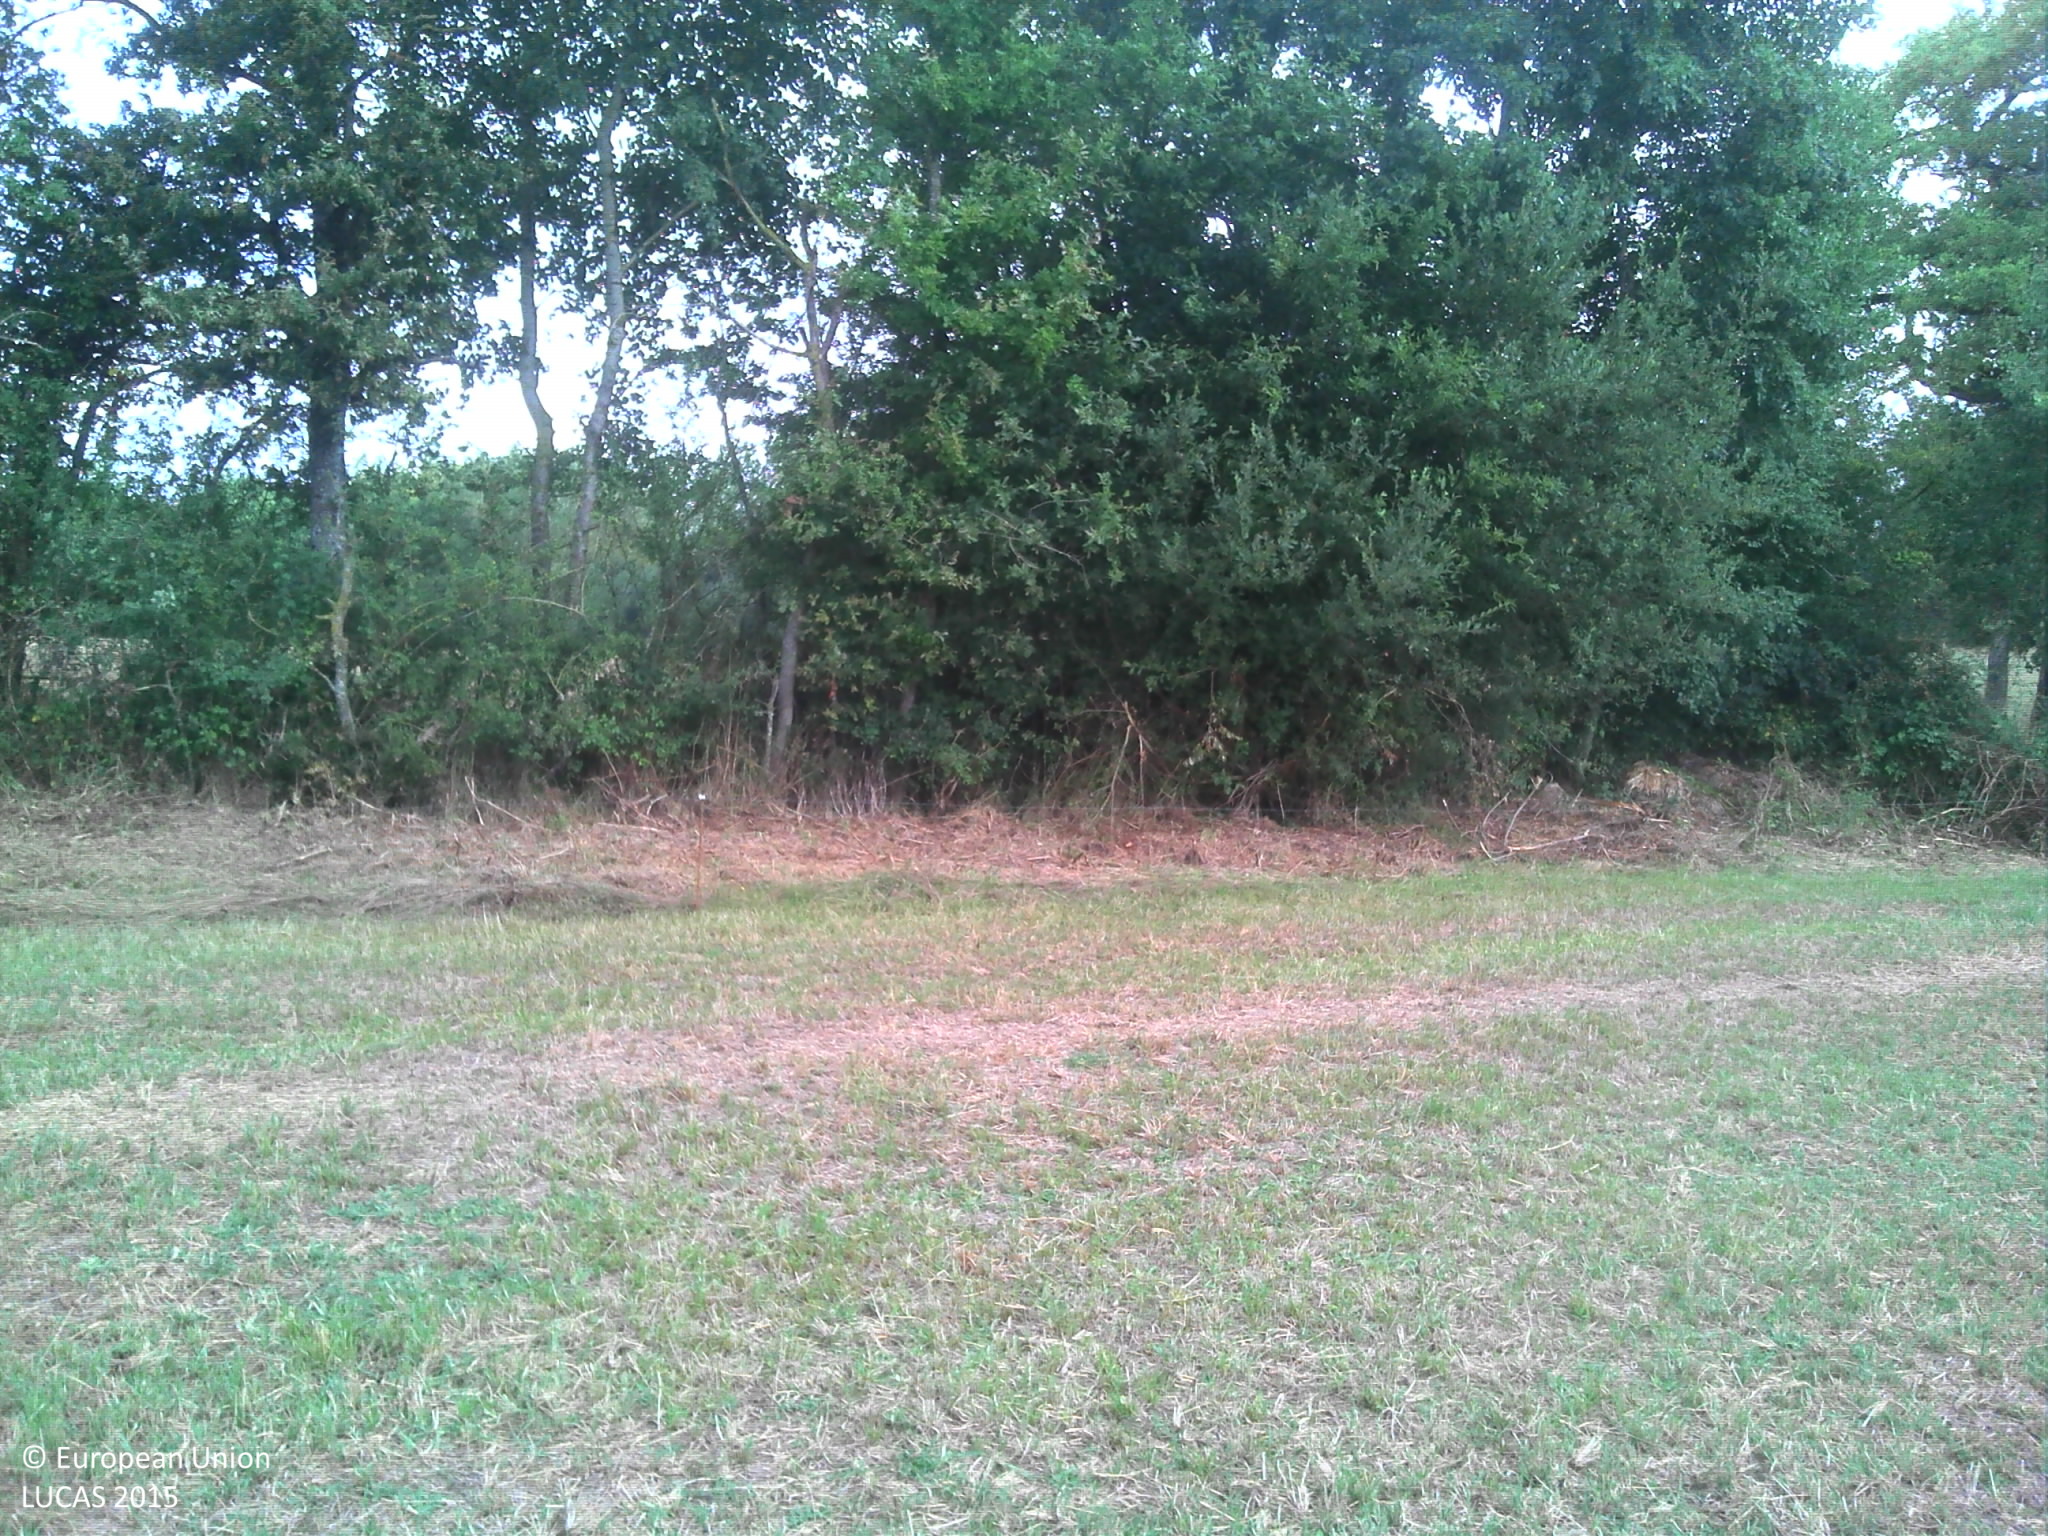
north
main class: Grassland
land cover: Grassland without tree/shrub cover
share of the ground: > 75 %
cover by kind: herbaceous plants 100 %
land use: Agriculture (excluding fallow land and kitchen gardens)
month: August
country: FR
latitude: 46.6273
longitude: -1.5984
